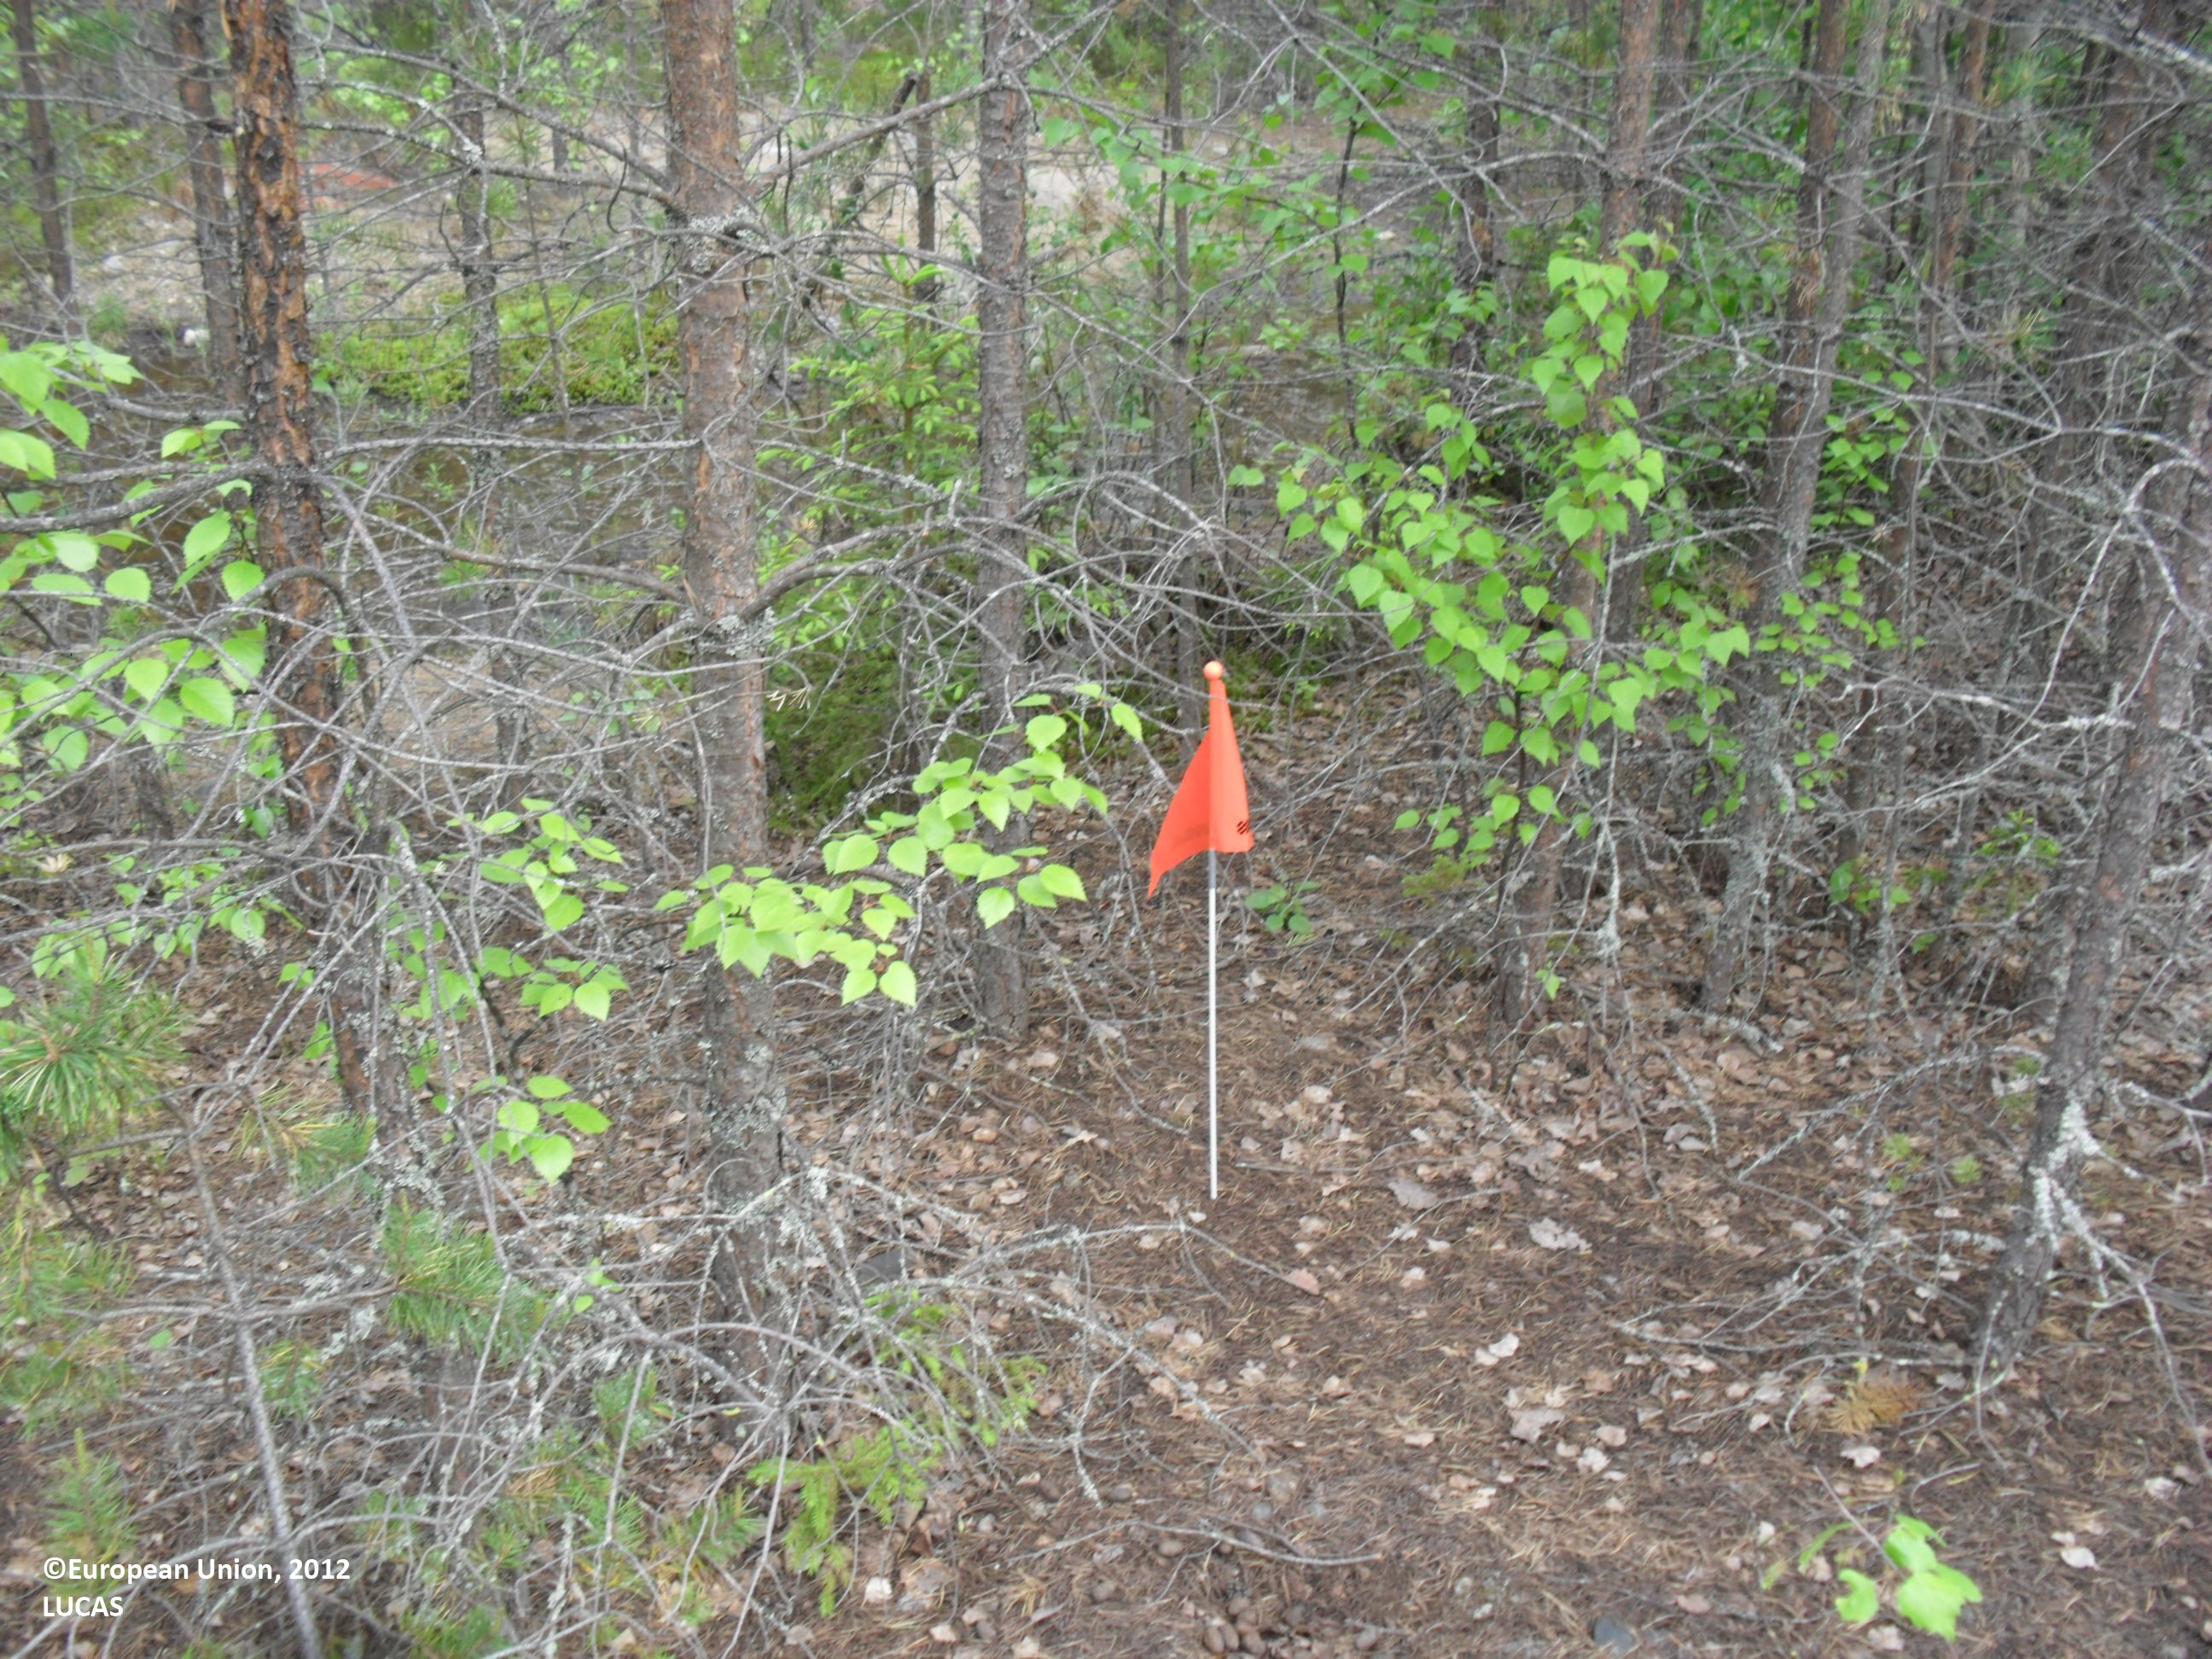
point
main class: Woodland
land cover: Pine dominated coniferous woodland
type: boreal forest
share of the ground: 50 - 75 %
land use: Forestry
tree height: < 5 m
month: June
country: FI
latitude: 63.0440
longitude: 23.7336
